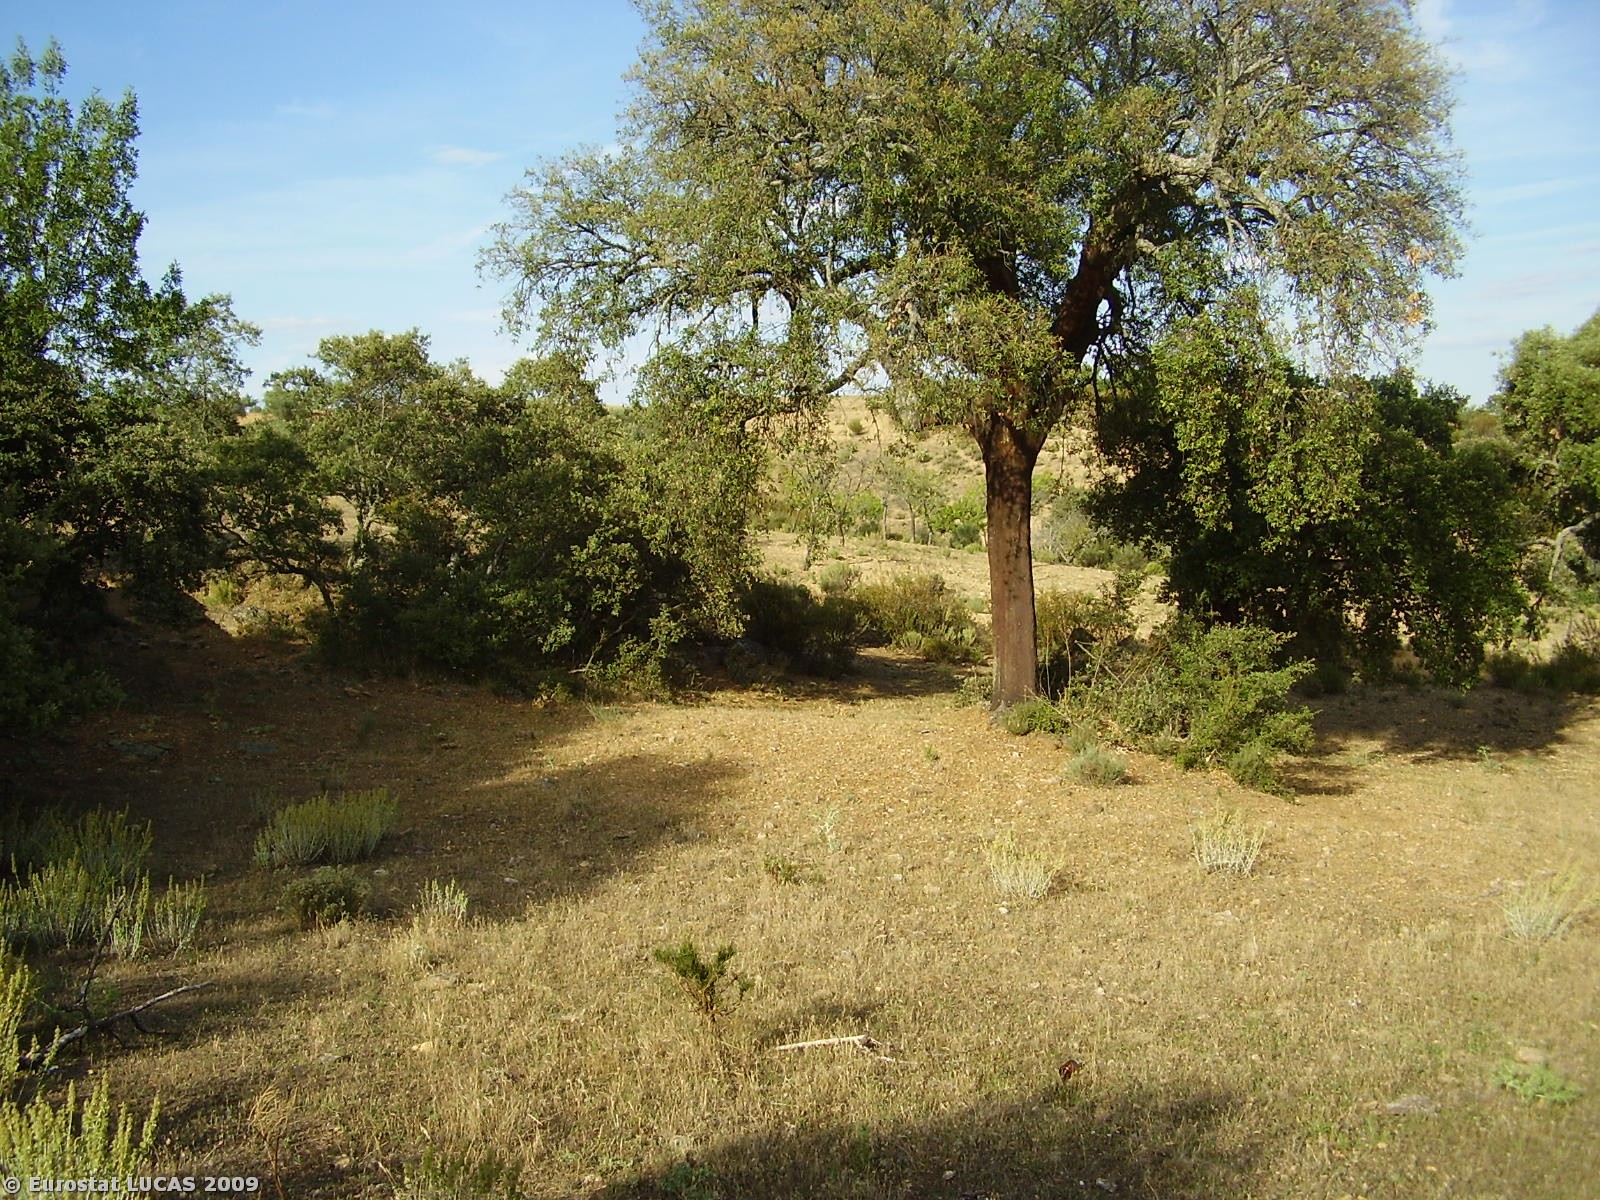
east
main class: Grassland
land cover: Grassland with sparse tree/shrub cover
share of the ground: 50 - 75 %
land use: Forestry
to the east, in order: Grassland with sparse tree/shrub cover; Broadleaved woodland; Ditches and canals; Nuts trees; Ditches and canals; Shrubland with sparse tree cover; Spontaneously vegetated surfaces
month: June
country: PT
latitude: 41.4797
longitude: -6.7914
